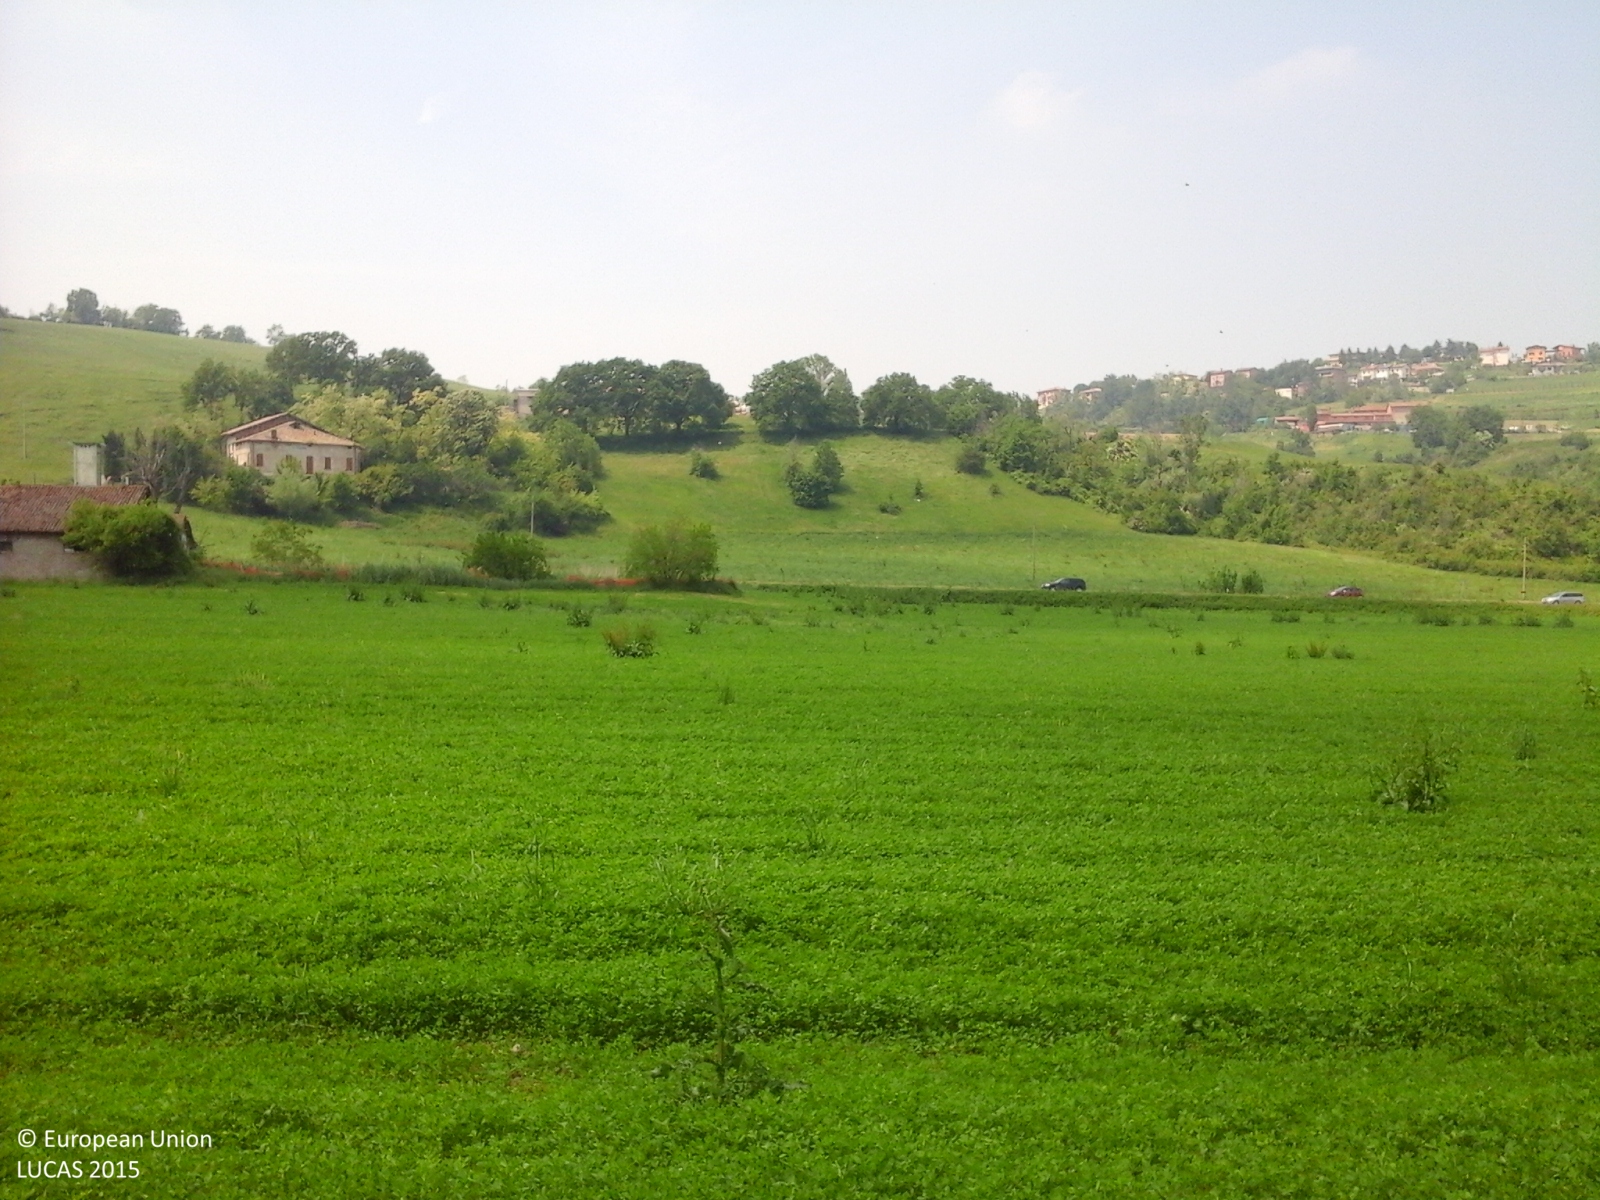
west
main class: Woodland
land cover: Broadleaved woodland
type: mesophytic deciduous forest
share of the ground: > 75 %
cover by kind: broadleaved forest trees 100 %
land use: Semi-natural and natural areas not in use
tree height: > 5 m
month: May
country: IT
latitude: 44.4912
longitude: 10.8658
